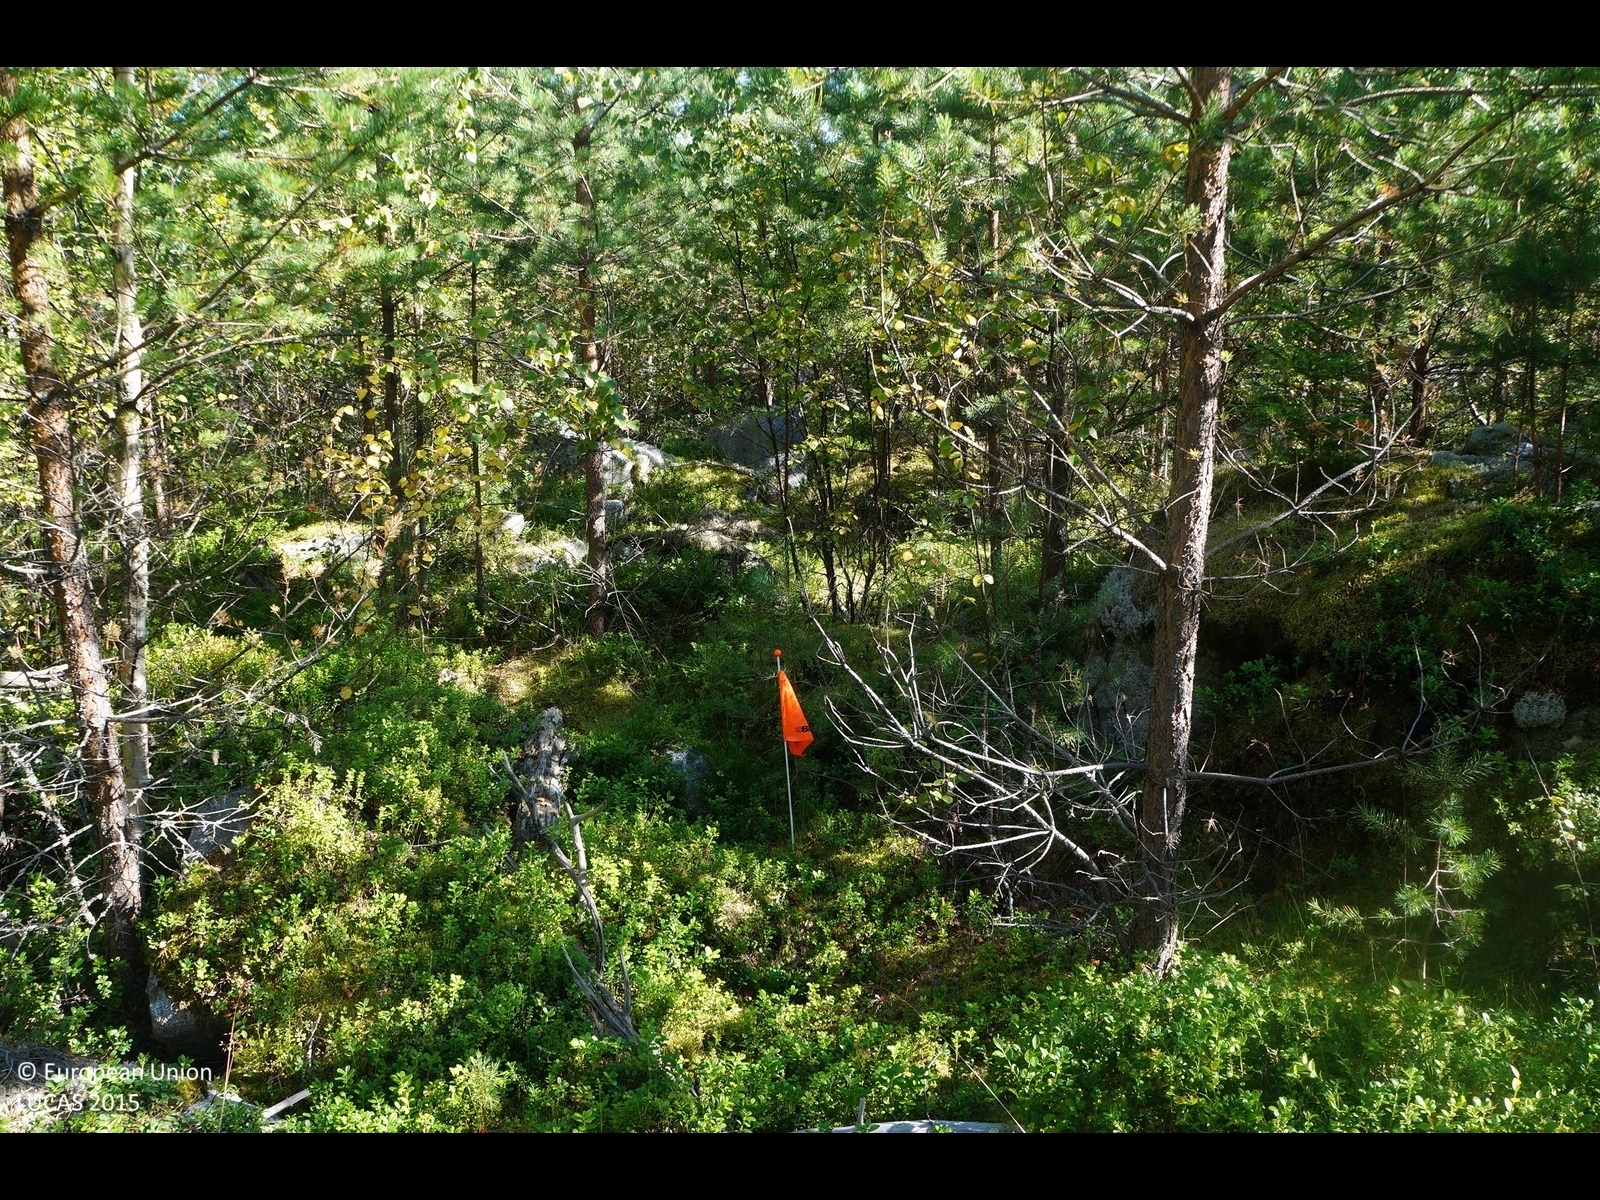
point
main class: Woodland
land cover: Pine dominated mixed woodland
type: boreal forest
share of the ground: 50 - 75 %
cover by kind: coniferous forest trees 50 %, broadleaved forest trees 20 %, shrubs 15 %, lichens and mosses 10 %, consolidated bare surface 5 %
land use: Forestry
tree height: > 5 m
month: August
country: FI
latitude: 63.7704
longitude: 22.7636
